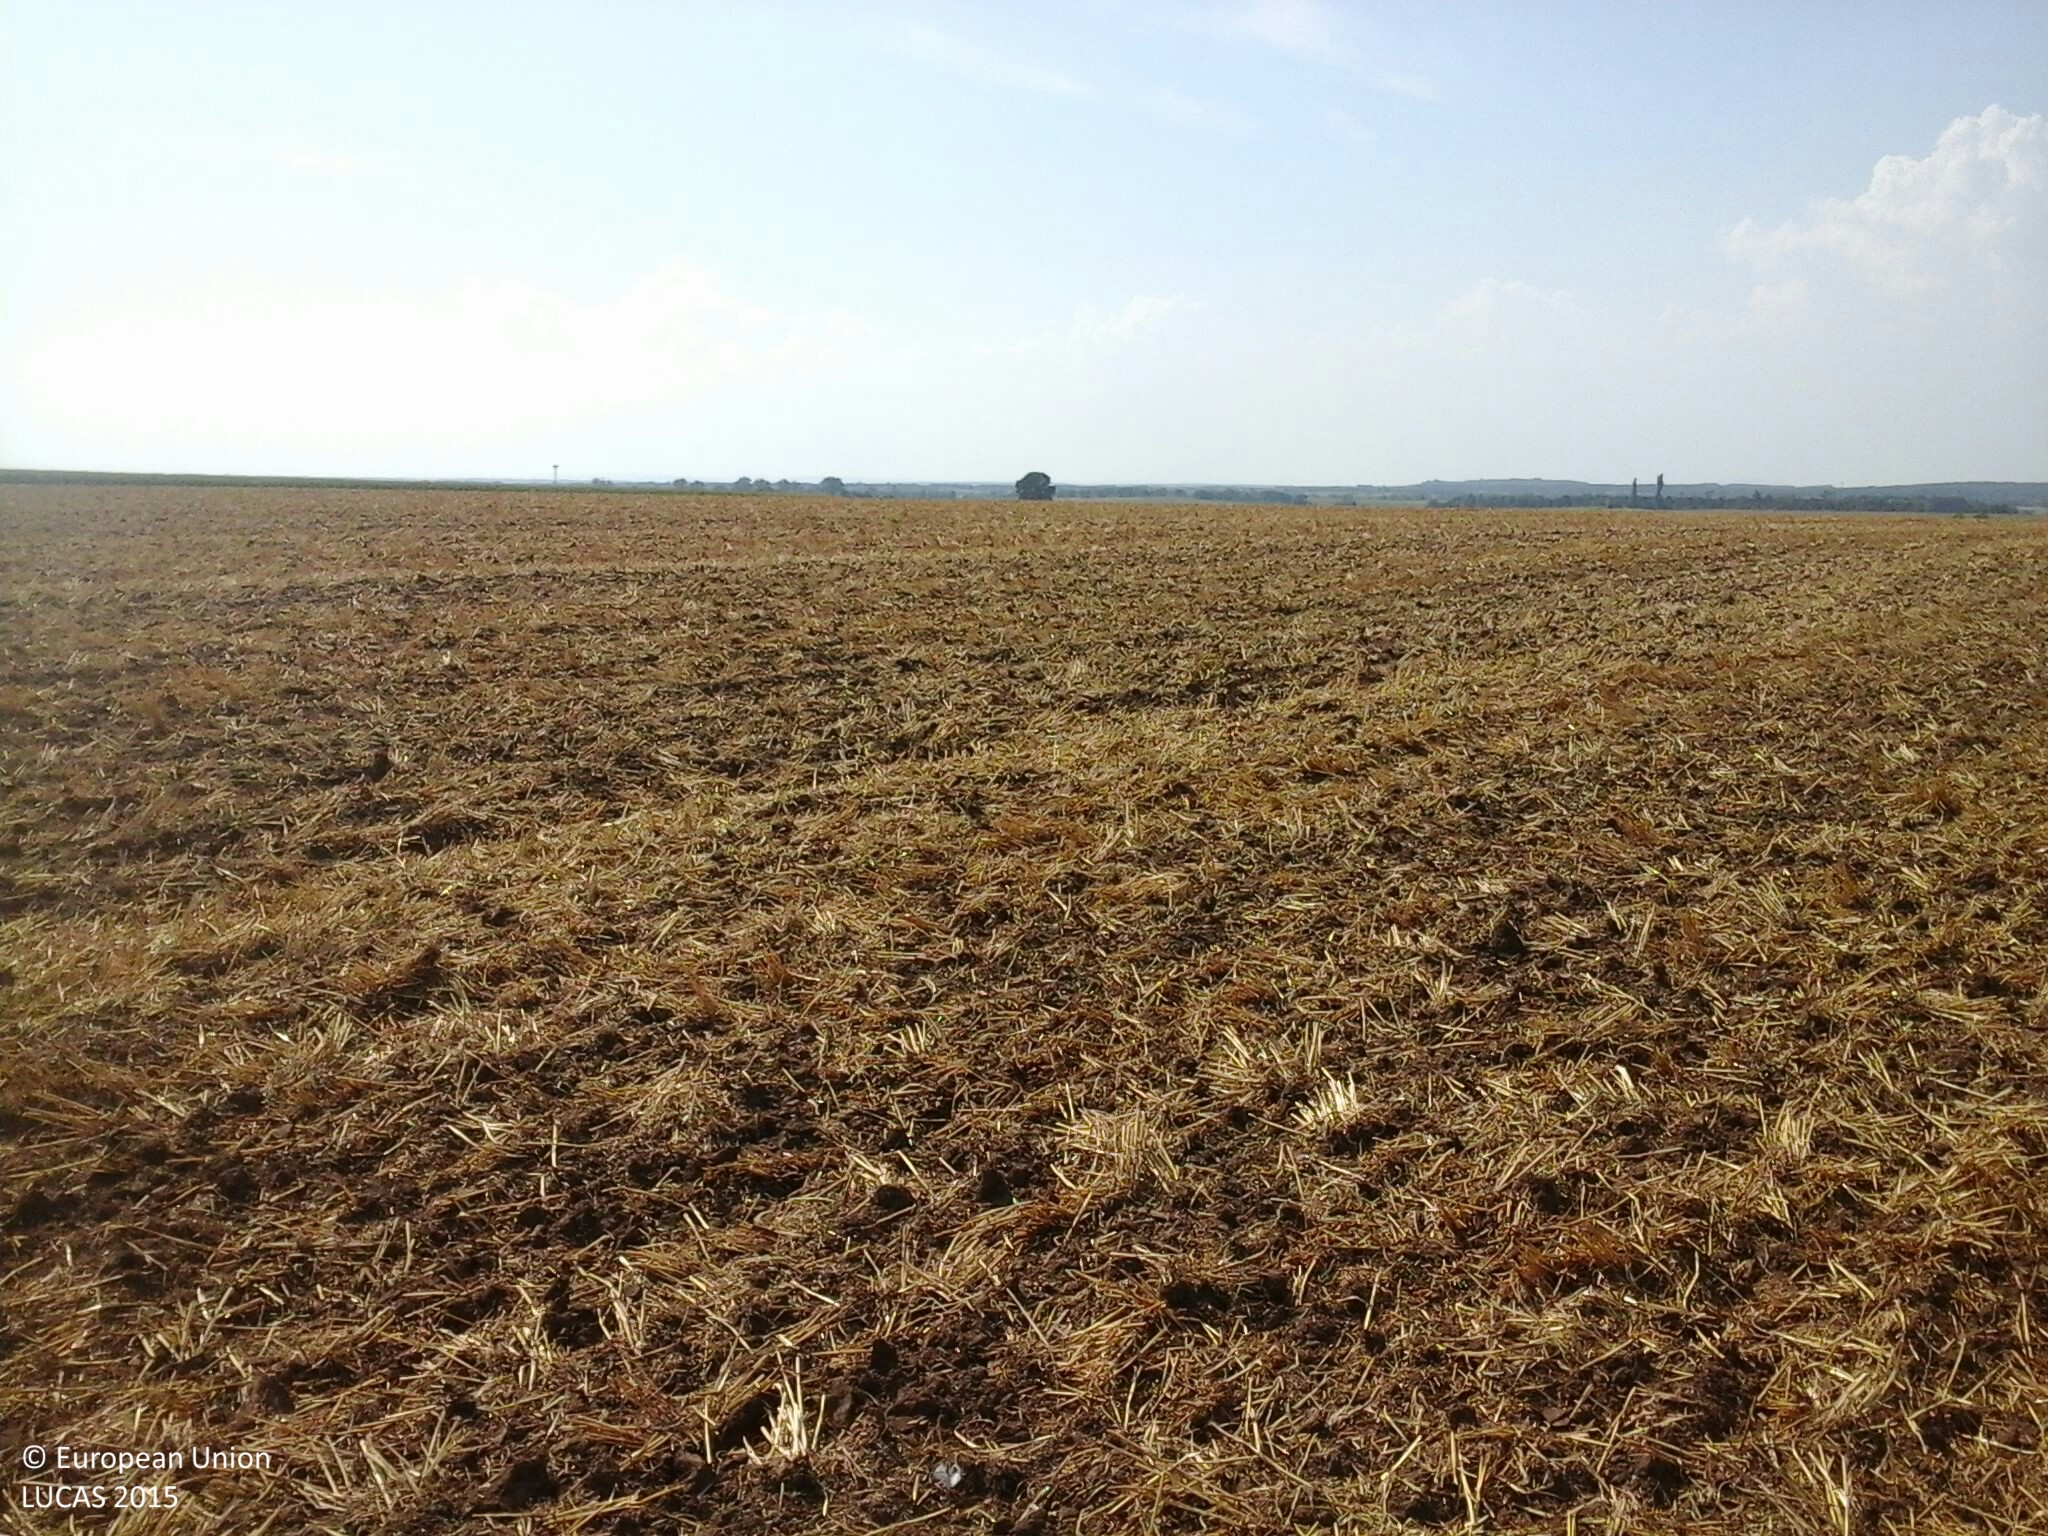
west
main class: Cropland
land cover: Common wheat
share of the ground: < 10 %
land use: Agriculture (excluding fallow land and kitchen gardens)
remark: Harvested field
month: August
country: HU
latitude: 47.0048
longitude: 18.3101
